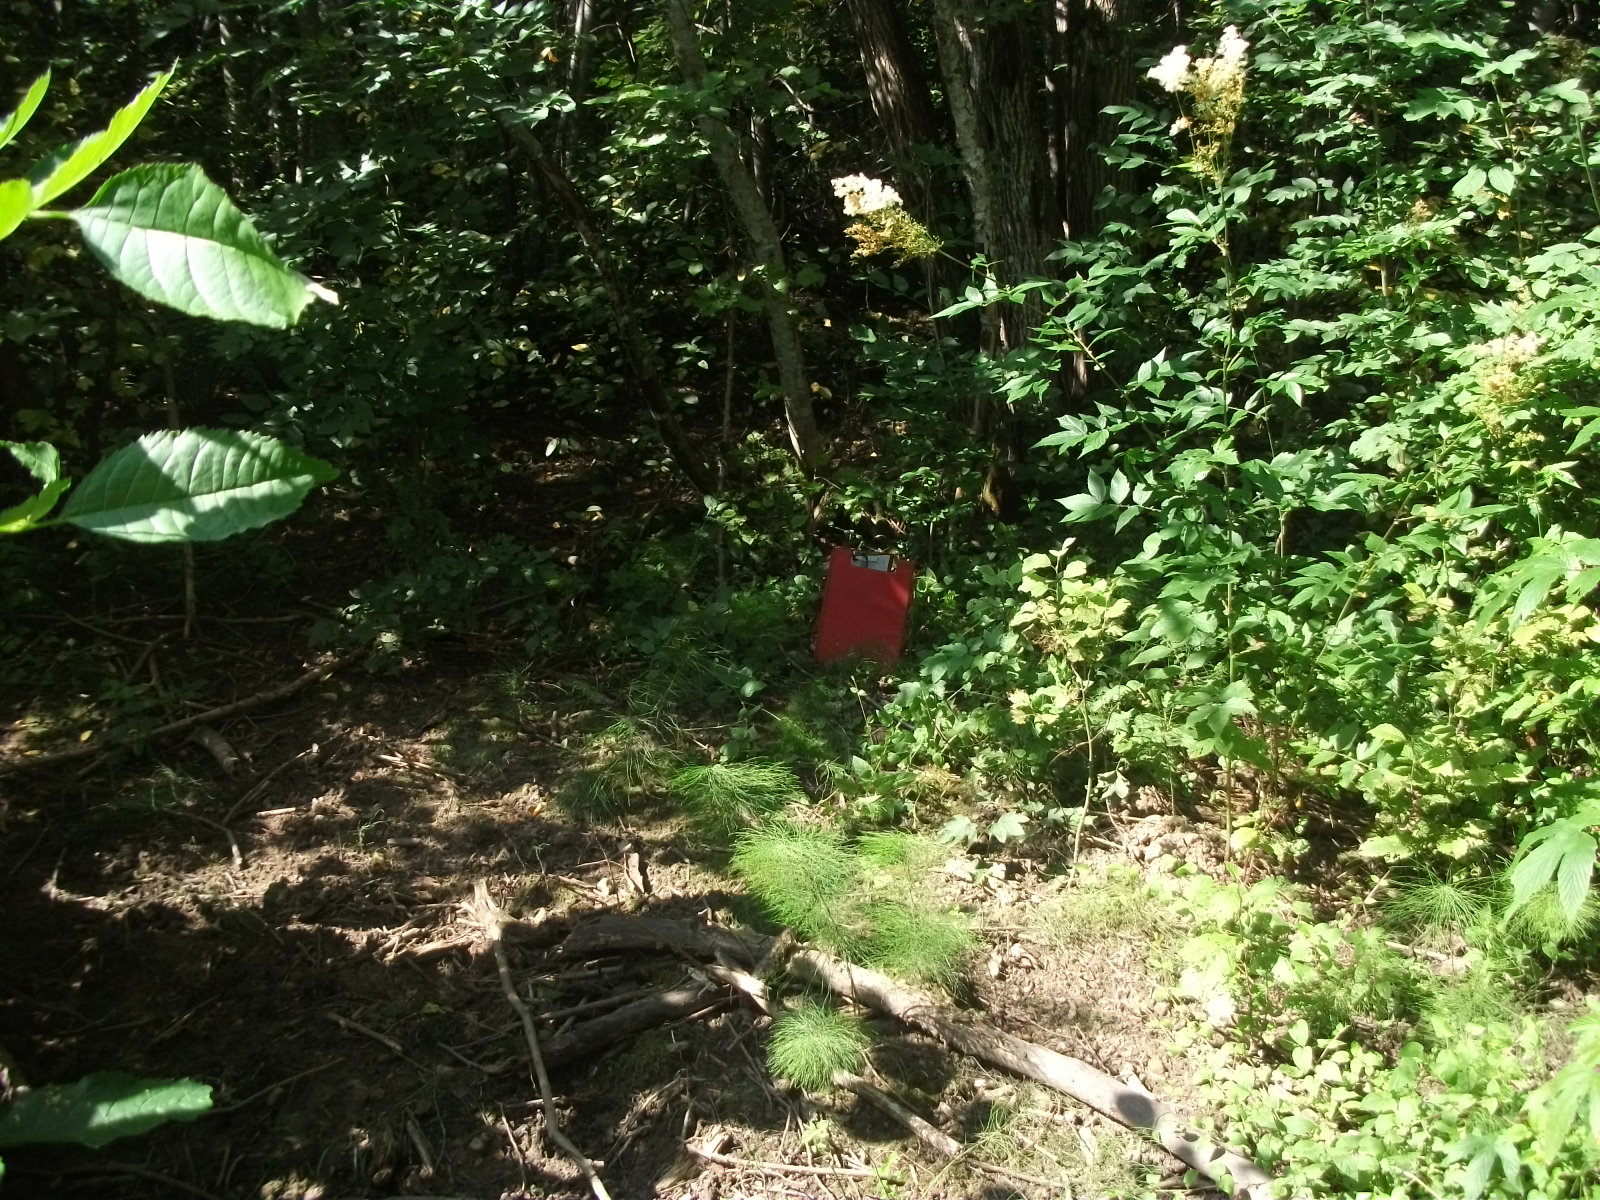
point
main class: Woodland
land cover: Broadleaved woodland
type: non-riverine alder, birch or aspen forest
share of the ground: 50 - 75 %
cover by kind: broadleaved forest trees 70 %, shrubs 10 %, herbaceous plants 10 %, unconsolidated bare surface 5 %
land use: Forestry
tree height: > 5 m
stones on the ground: < 10 %
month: August
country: LV
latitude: 56.8256
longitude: 25.5726
